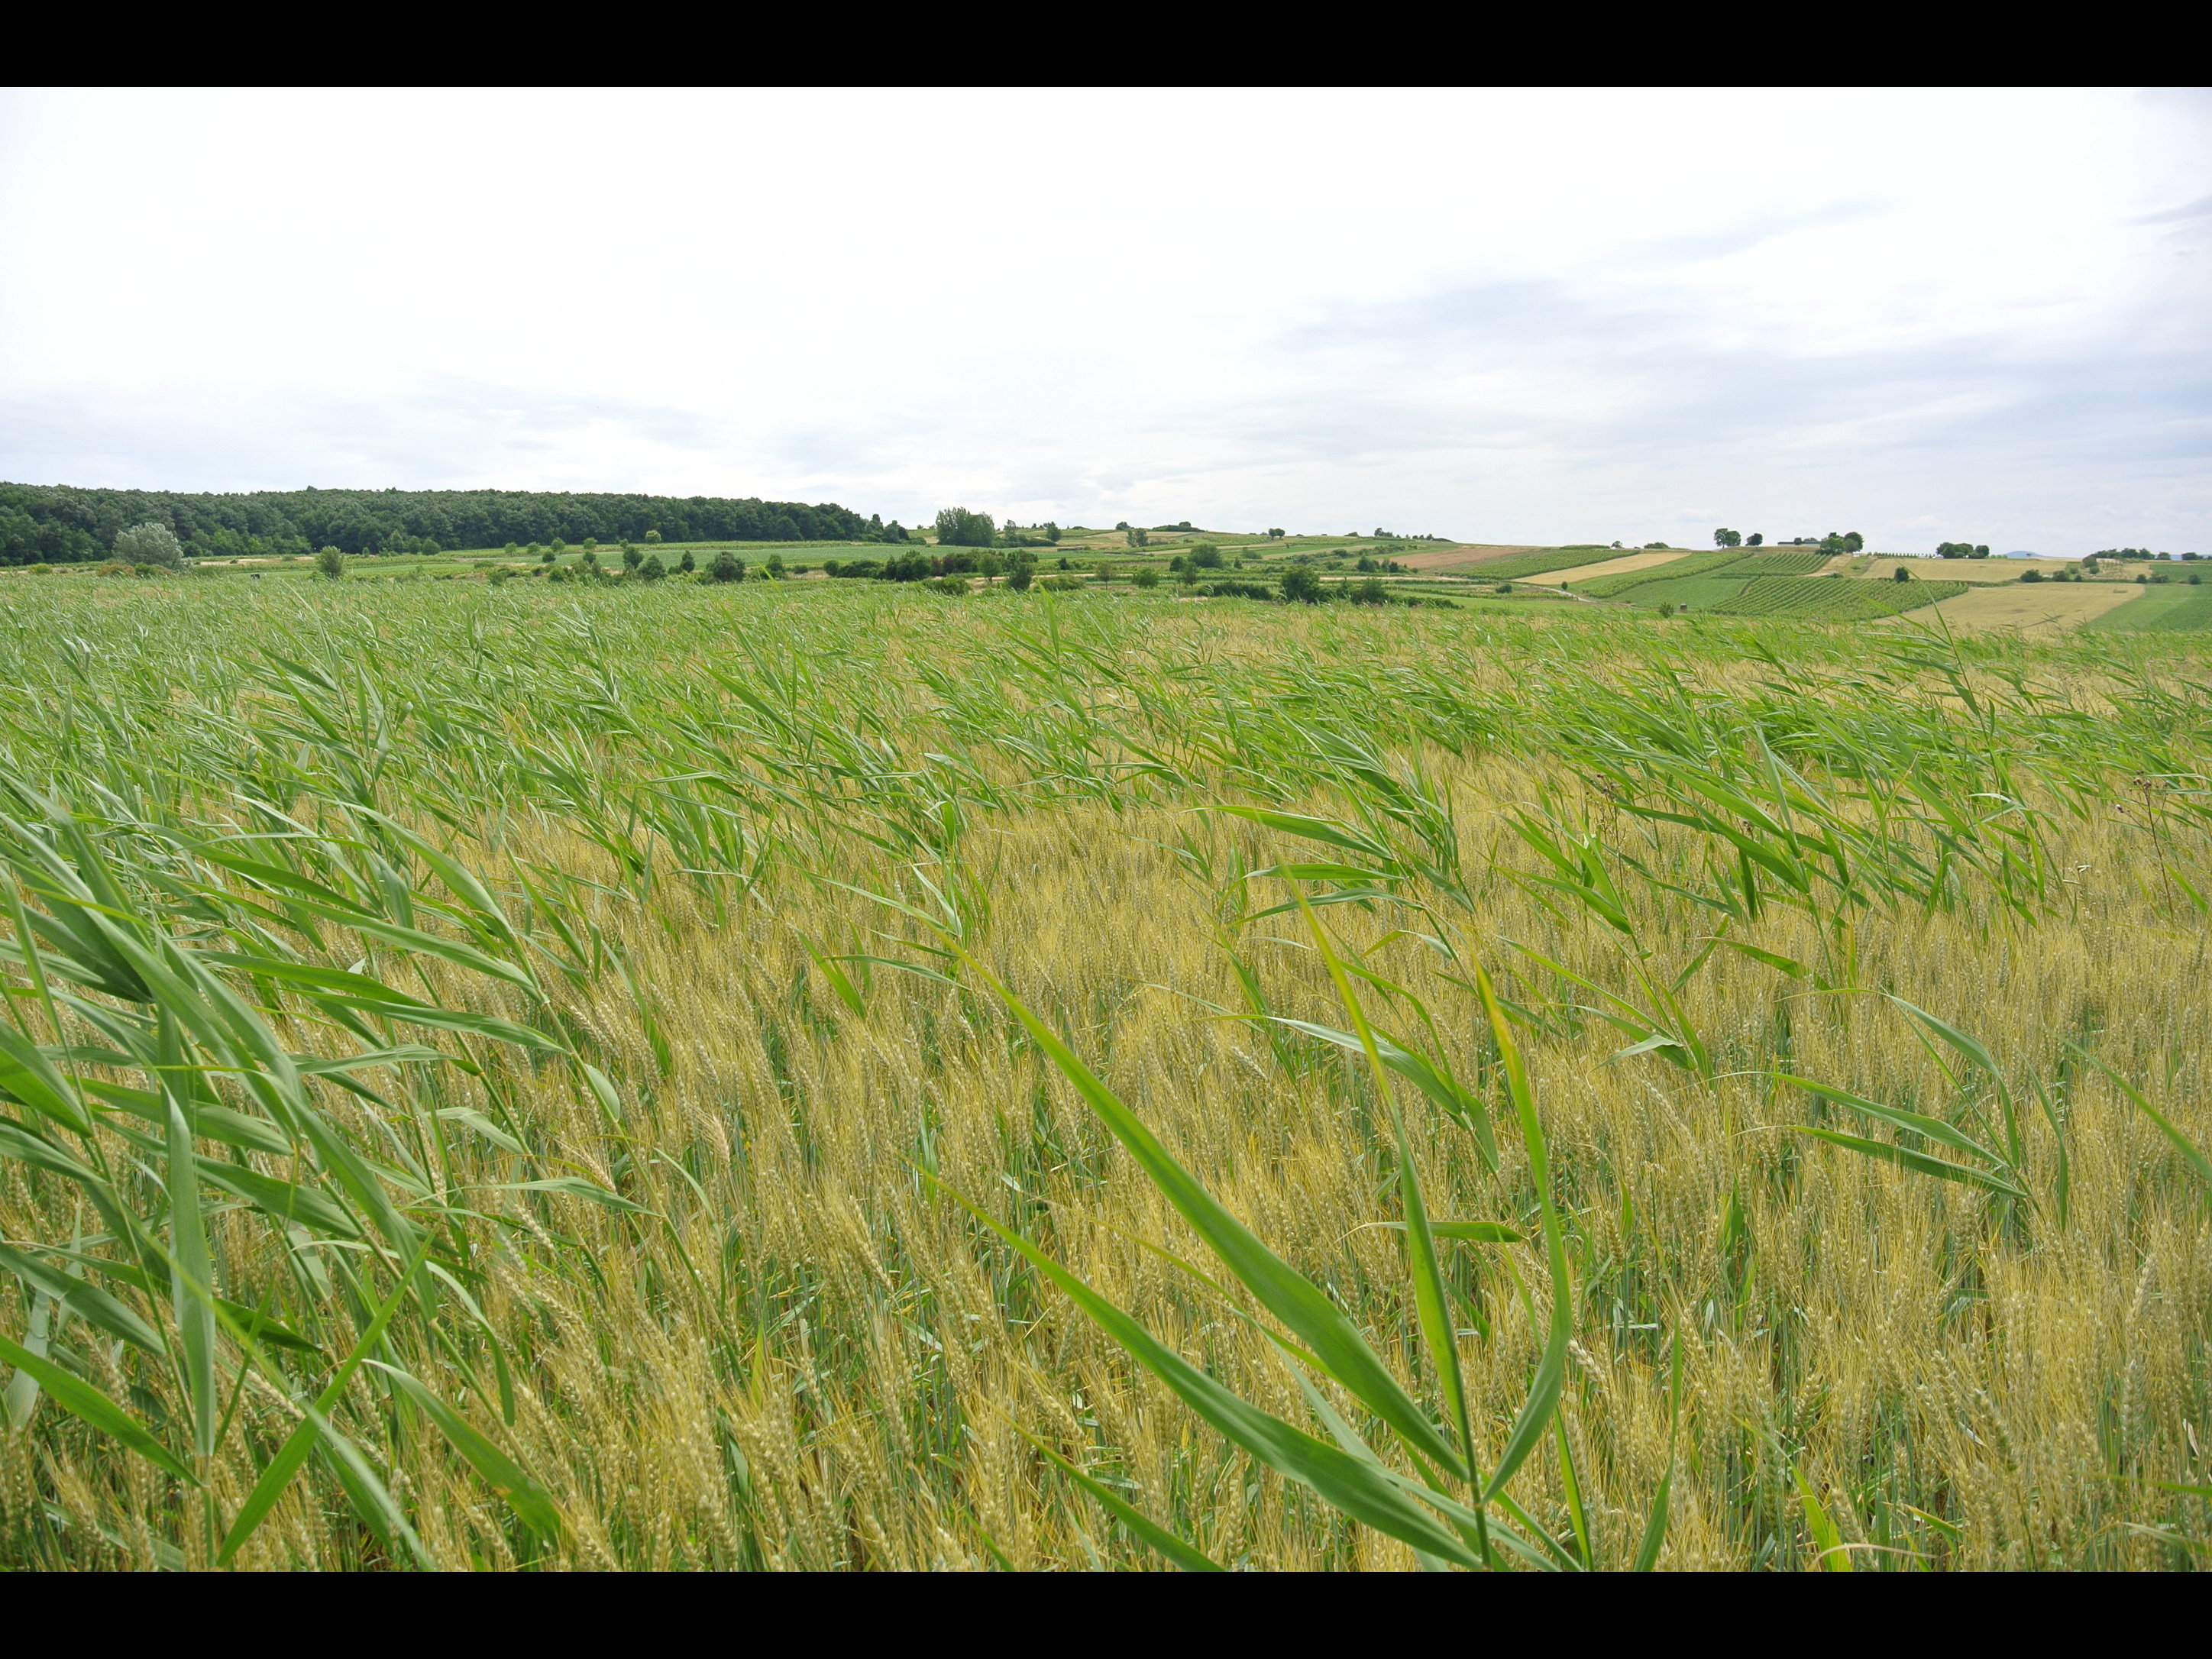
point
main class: Cropland
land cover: Common wheat
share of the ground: > 75 %
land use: Agriculture (excluding fallow land and kitchen gardens)
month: June
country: AT
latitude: 47.7592
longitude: 16.5282
